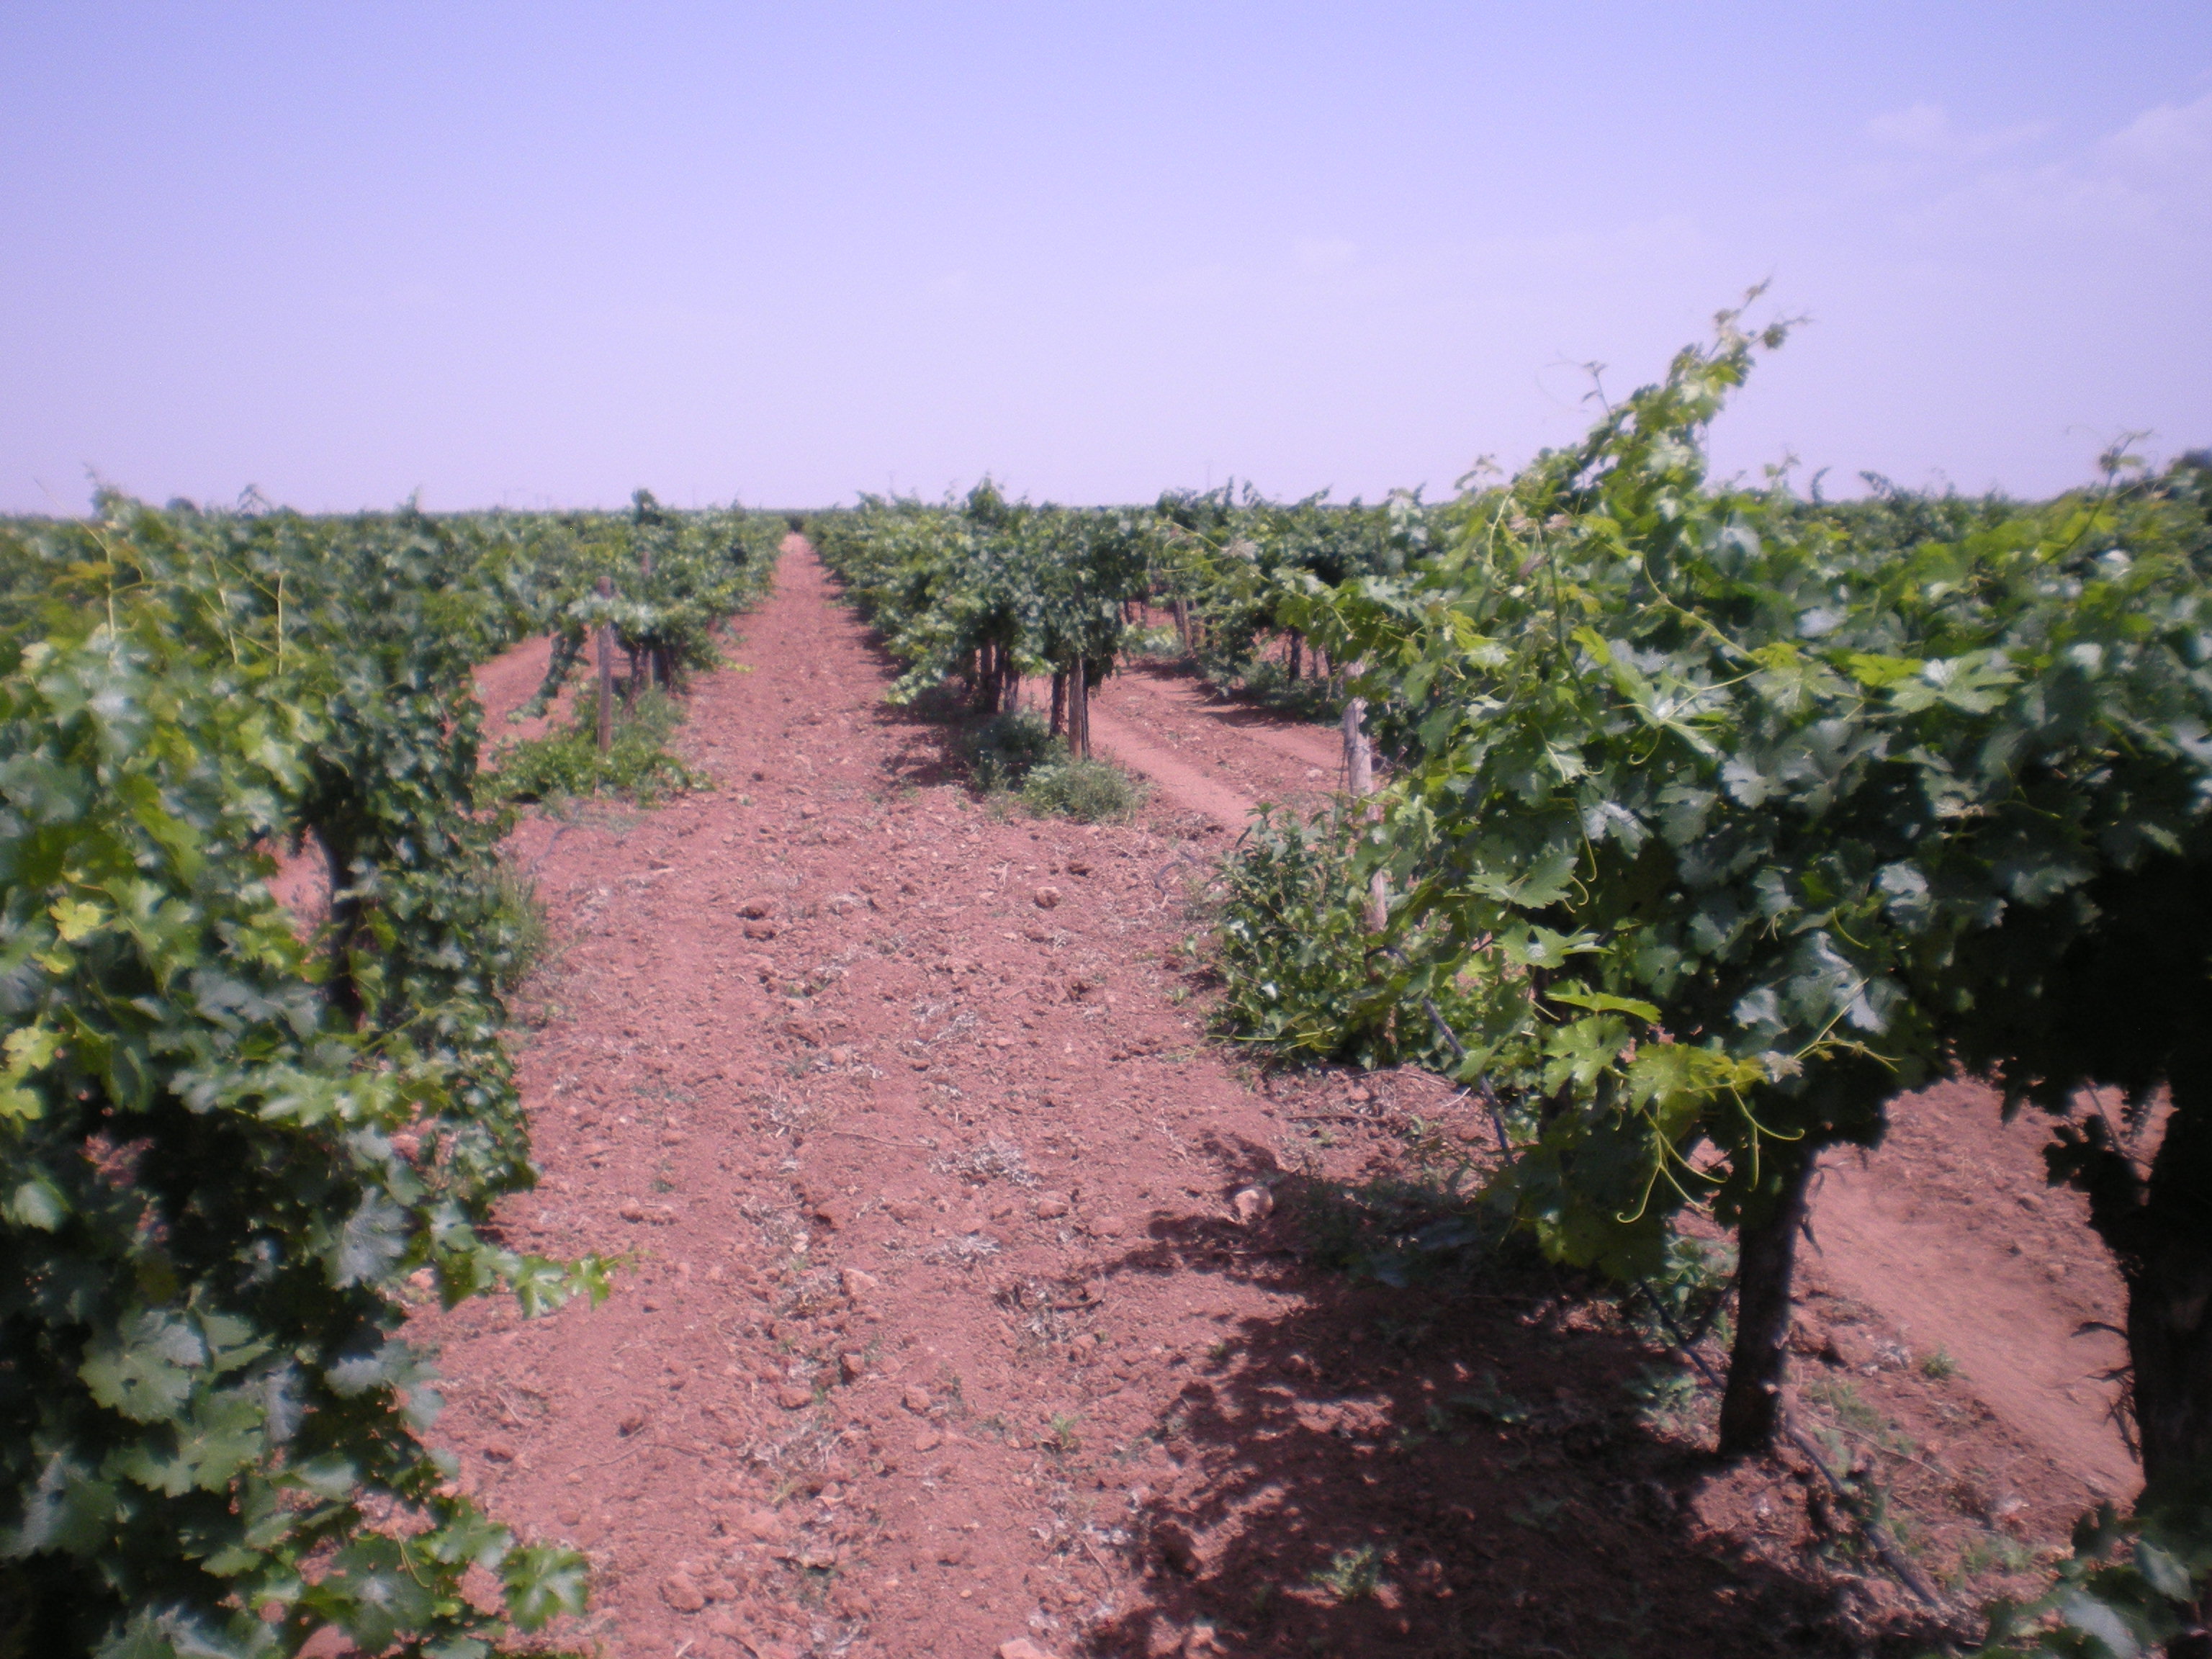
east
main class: Cropland
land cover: Vineyards
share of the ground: 10 - 25 %
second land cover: Other bare soil
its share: > 75 %
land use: Agriculture (excluding fallow land and kitchen gardens)
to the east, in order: Vineyards; Other bare soil; Tracks; Vineyards
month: July
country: ES
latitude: 39.2506
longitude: -3.1441
